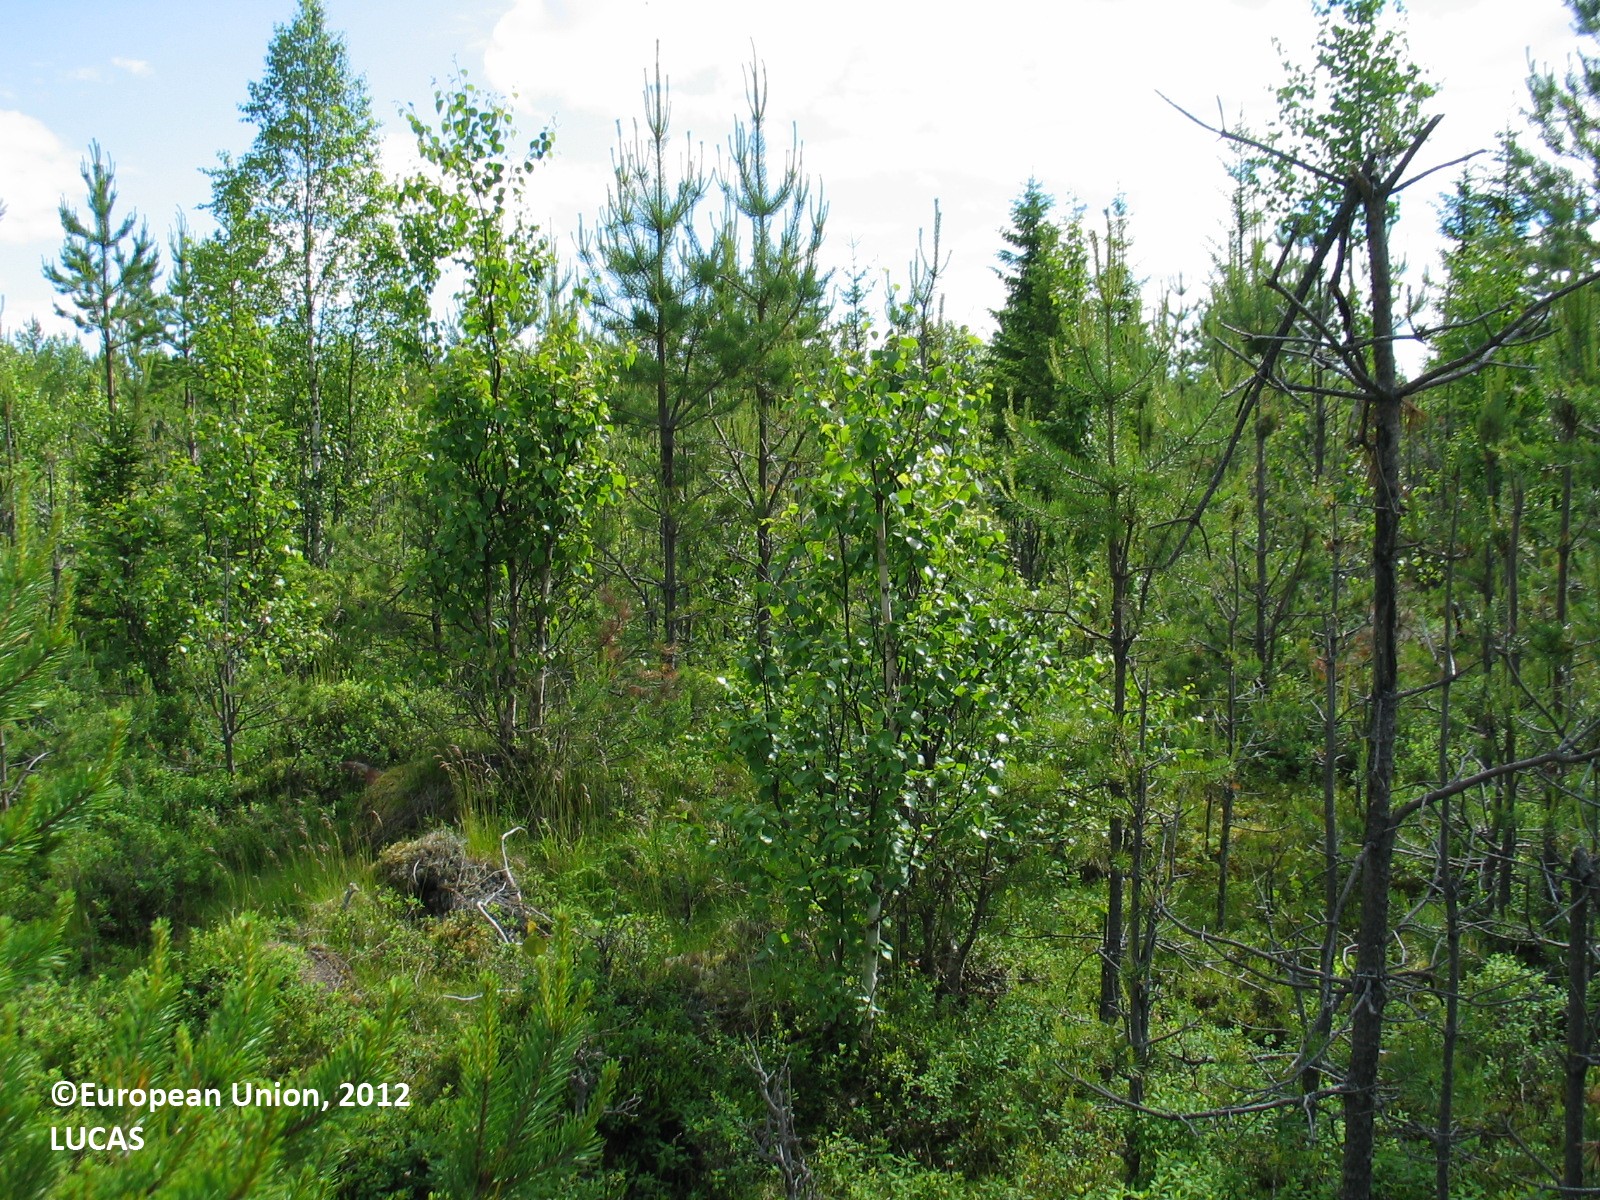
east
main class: Woodland
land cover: Other mixed woodland
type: boreal forest
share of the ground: 25 - 50 %
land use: Forestry
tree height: < 5 m
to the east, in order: Other mixed woodland; Pine dominated coniferous woodland; Grassland without tree/shrub cover; Pine dominated coniferous woodland
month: July
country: FI
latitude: 64.7563
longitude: 26.6114
